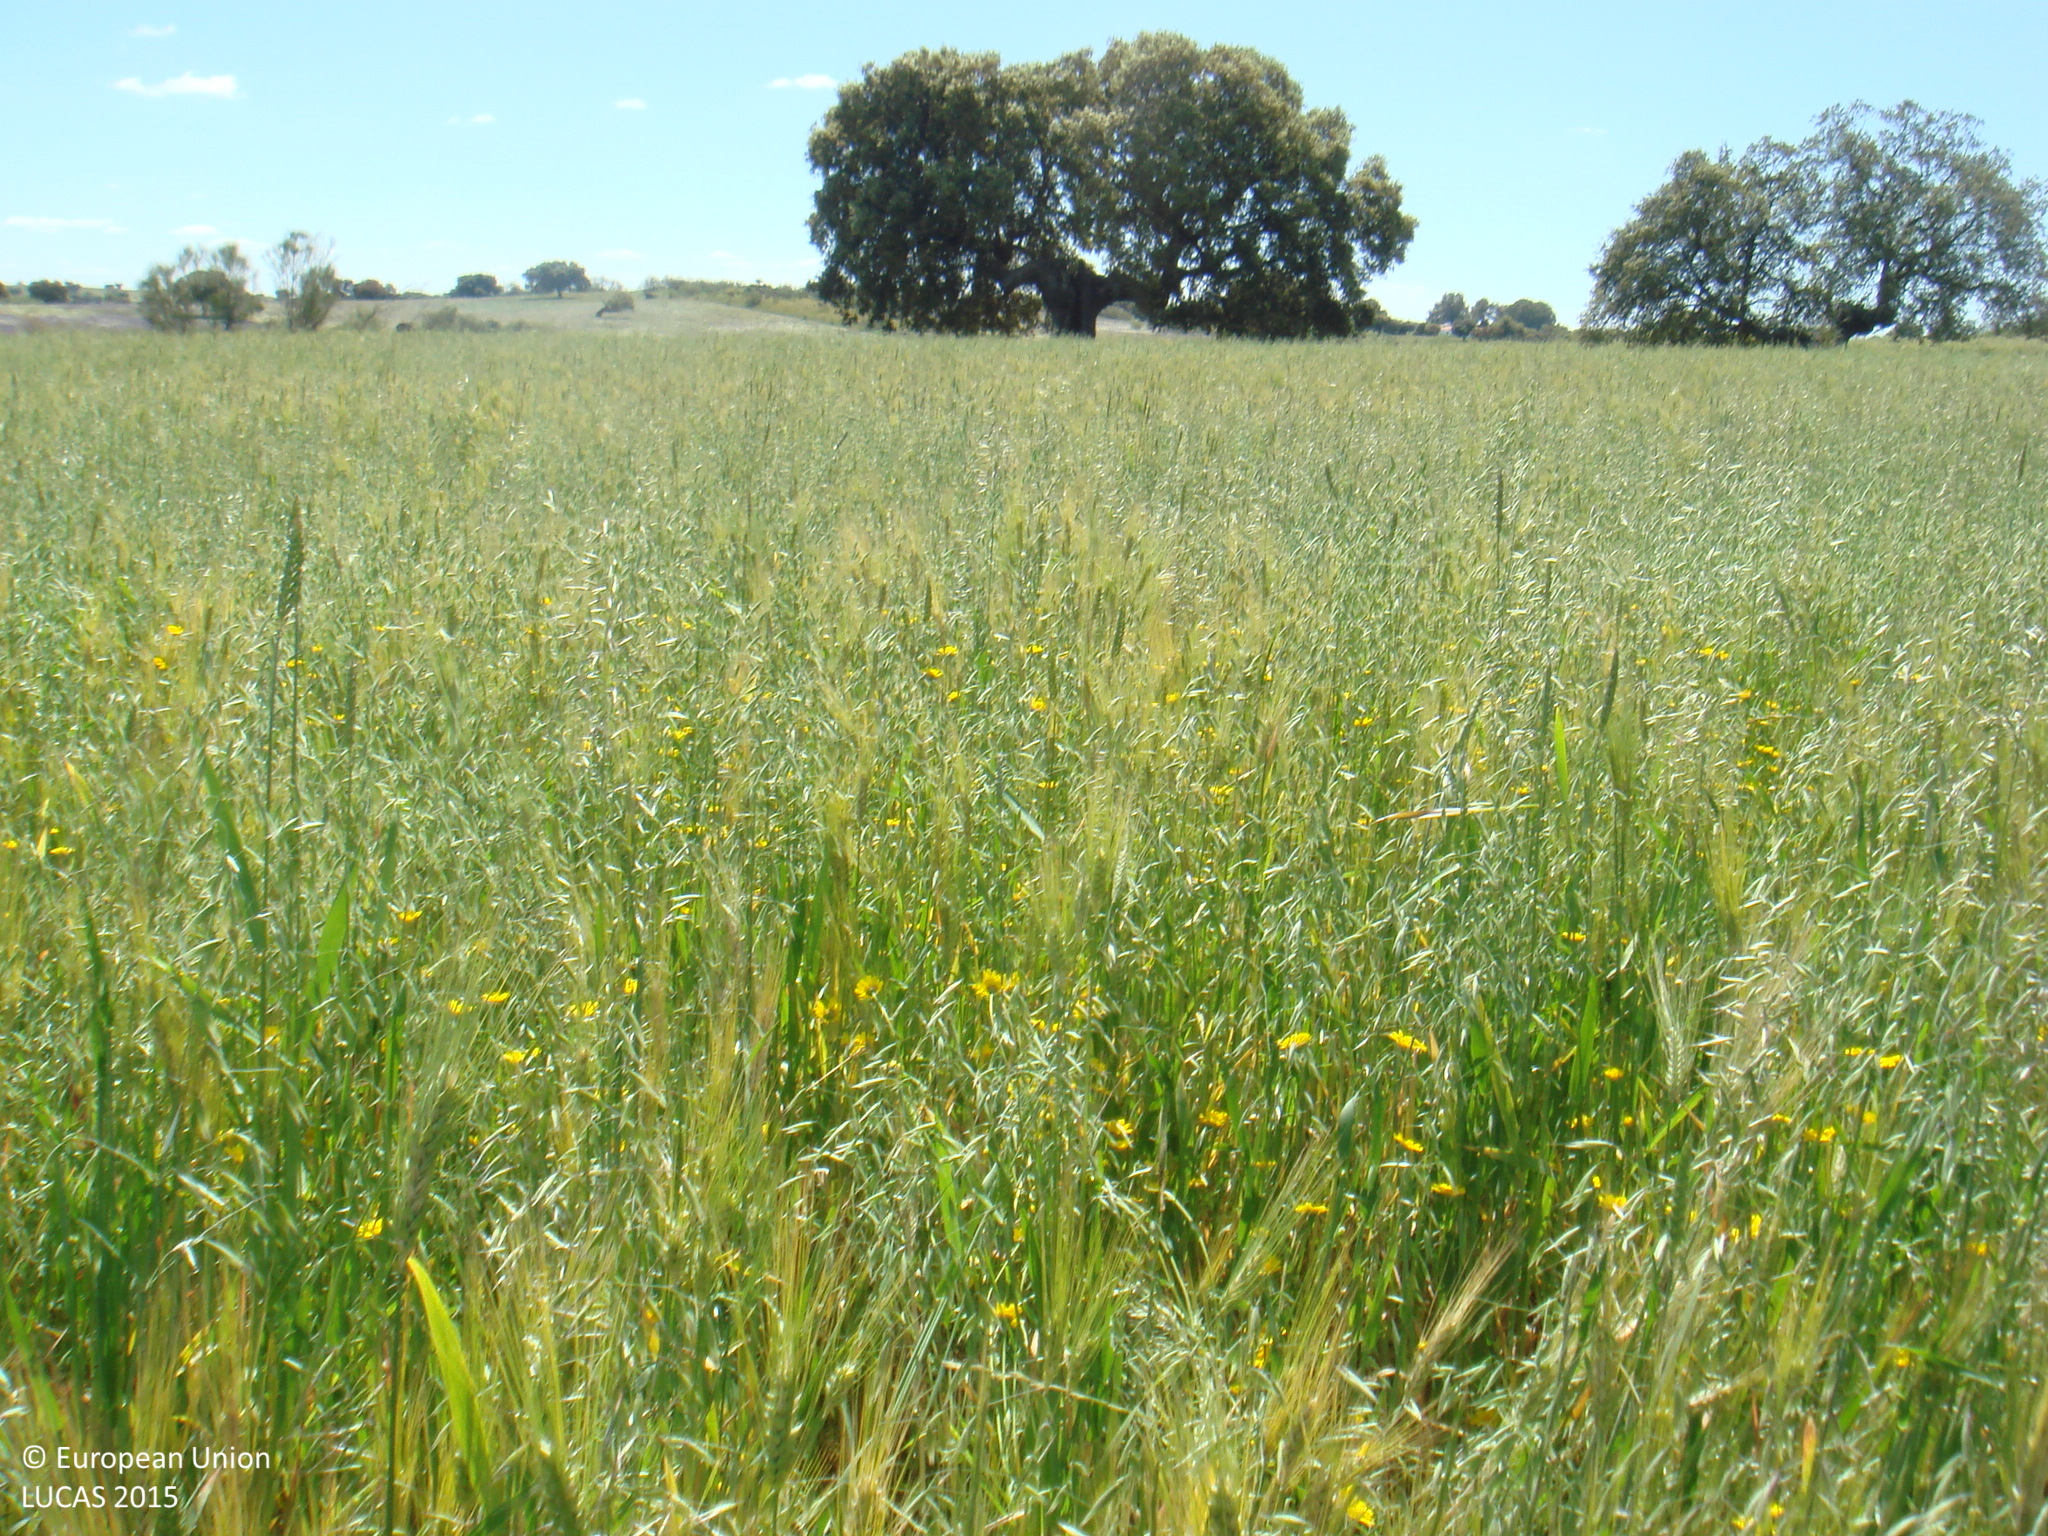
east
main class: Cropland
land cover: Mixed cereals for fodder
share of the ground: > 75 %
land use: Agriculture (excluding fallow land and kitchen gardens)
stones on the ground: 10 - 25 %
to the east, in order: Mixed cereals for fodder; Grassland with sparse tree/shrub cover; Grass margins; Conifer hedges; Grass margins; Common wheat; Grassland with sparse tree/shrub cover; Common wheat
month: April
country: ES
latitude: 38.5088
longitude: -5.0630
